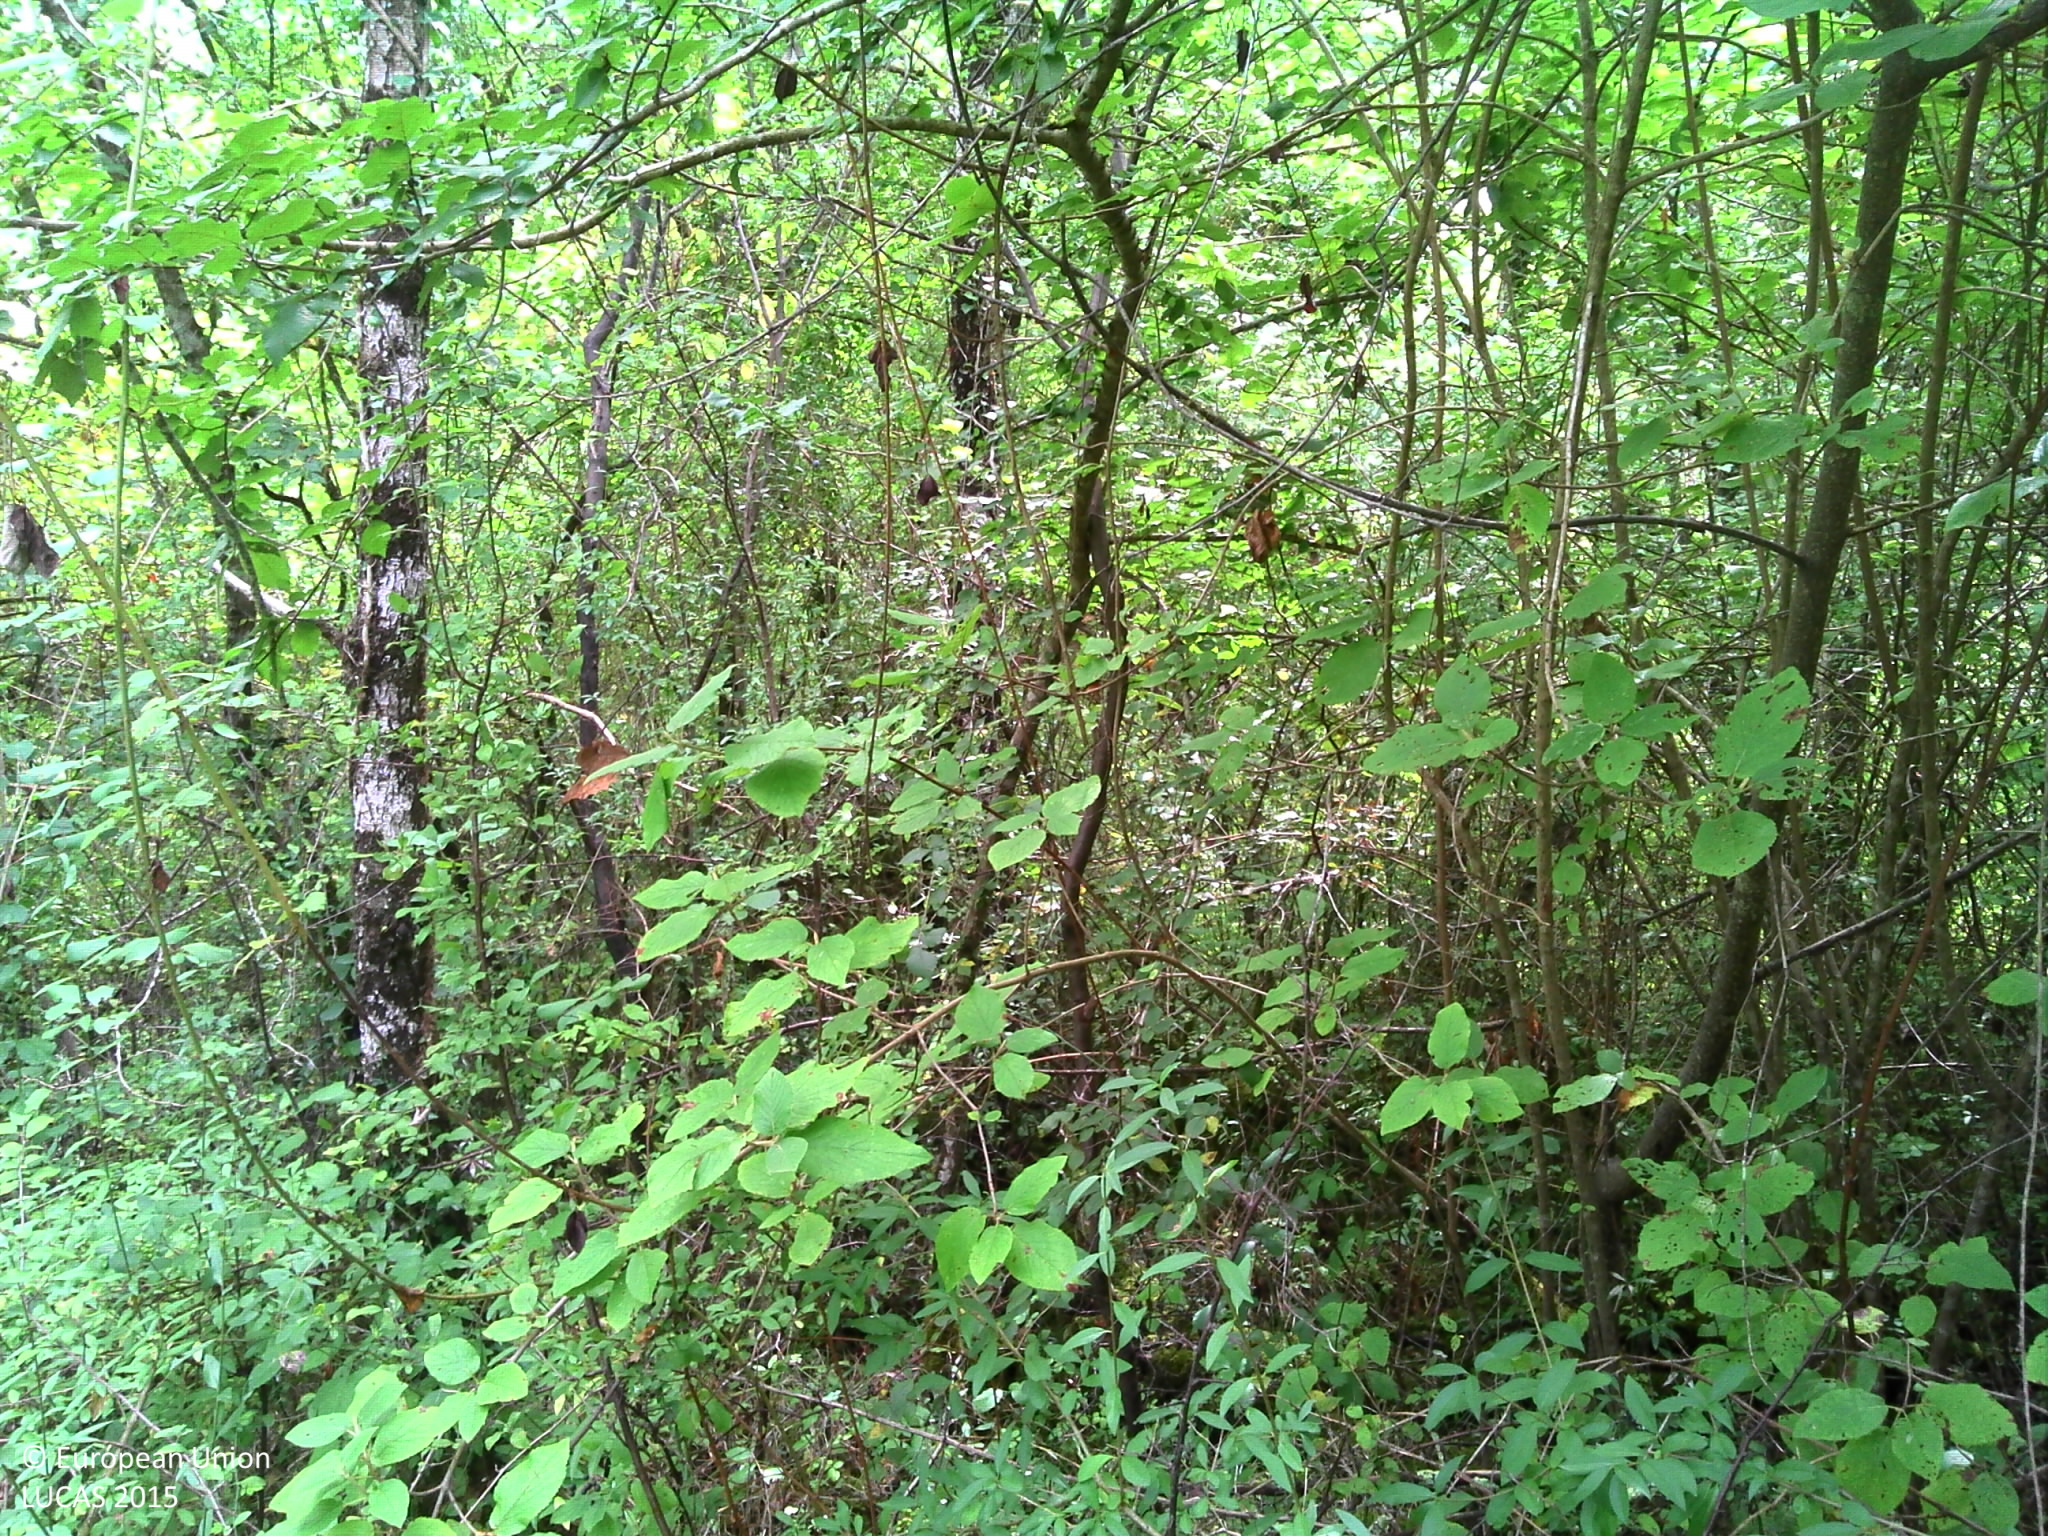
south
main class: Woodland
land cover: Broadleaved woodland
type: mesophytic deciduous forest
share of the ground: > 75 %
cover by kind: broadleaved forest trees 70 %, shrubs 20 %, herbaceous plants 10 %
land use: Forestry
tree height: > 5 m
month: August
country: FR
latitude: 45.2872
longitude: 0.4381
